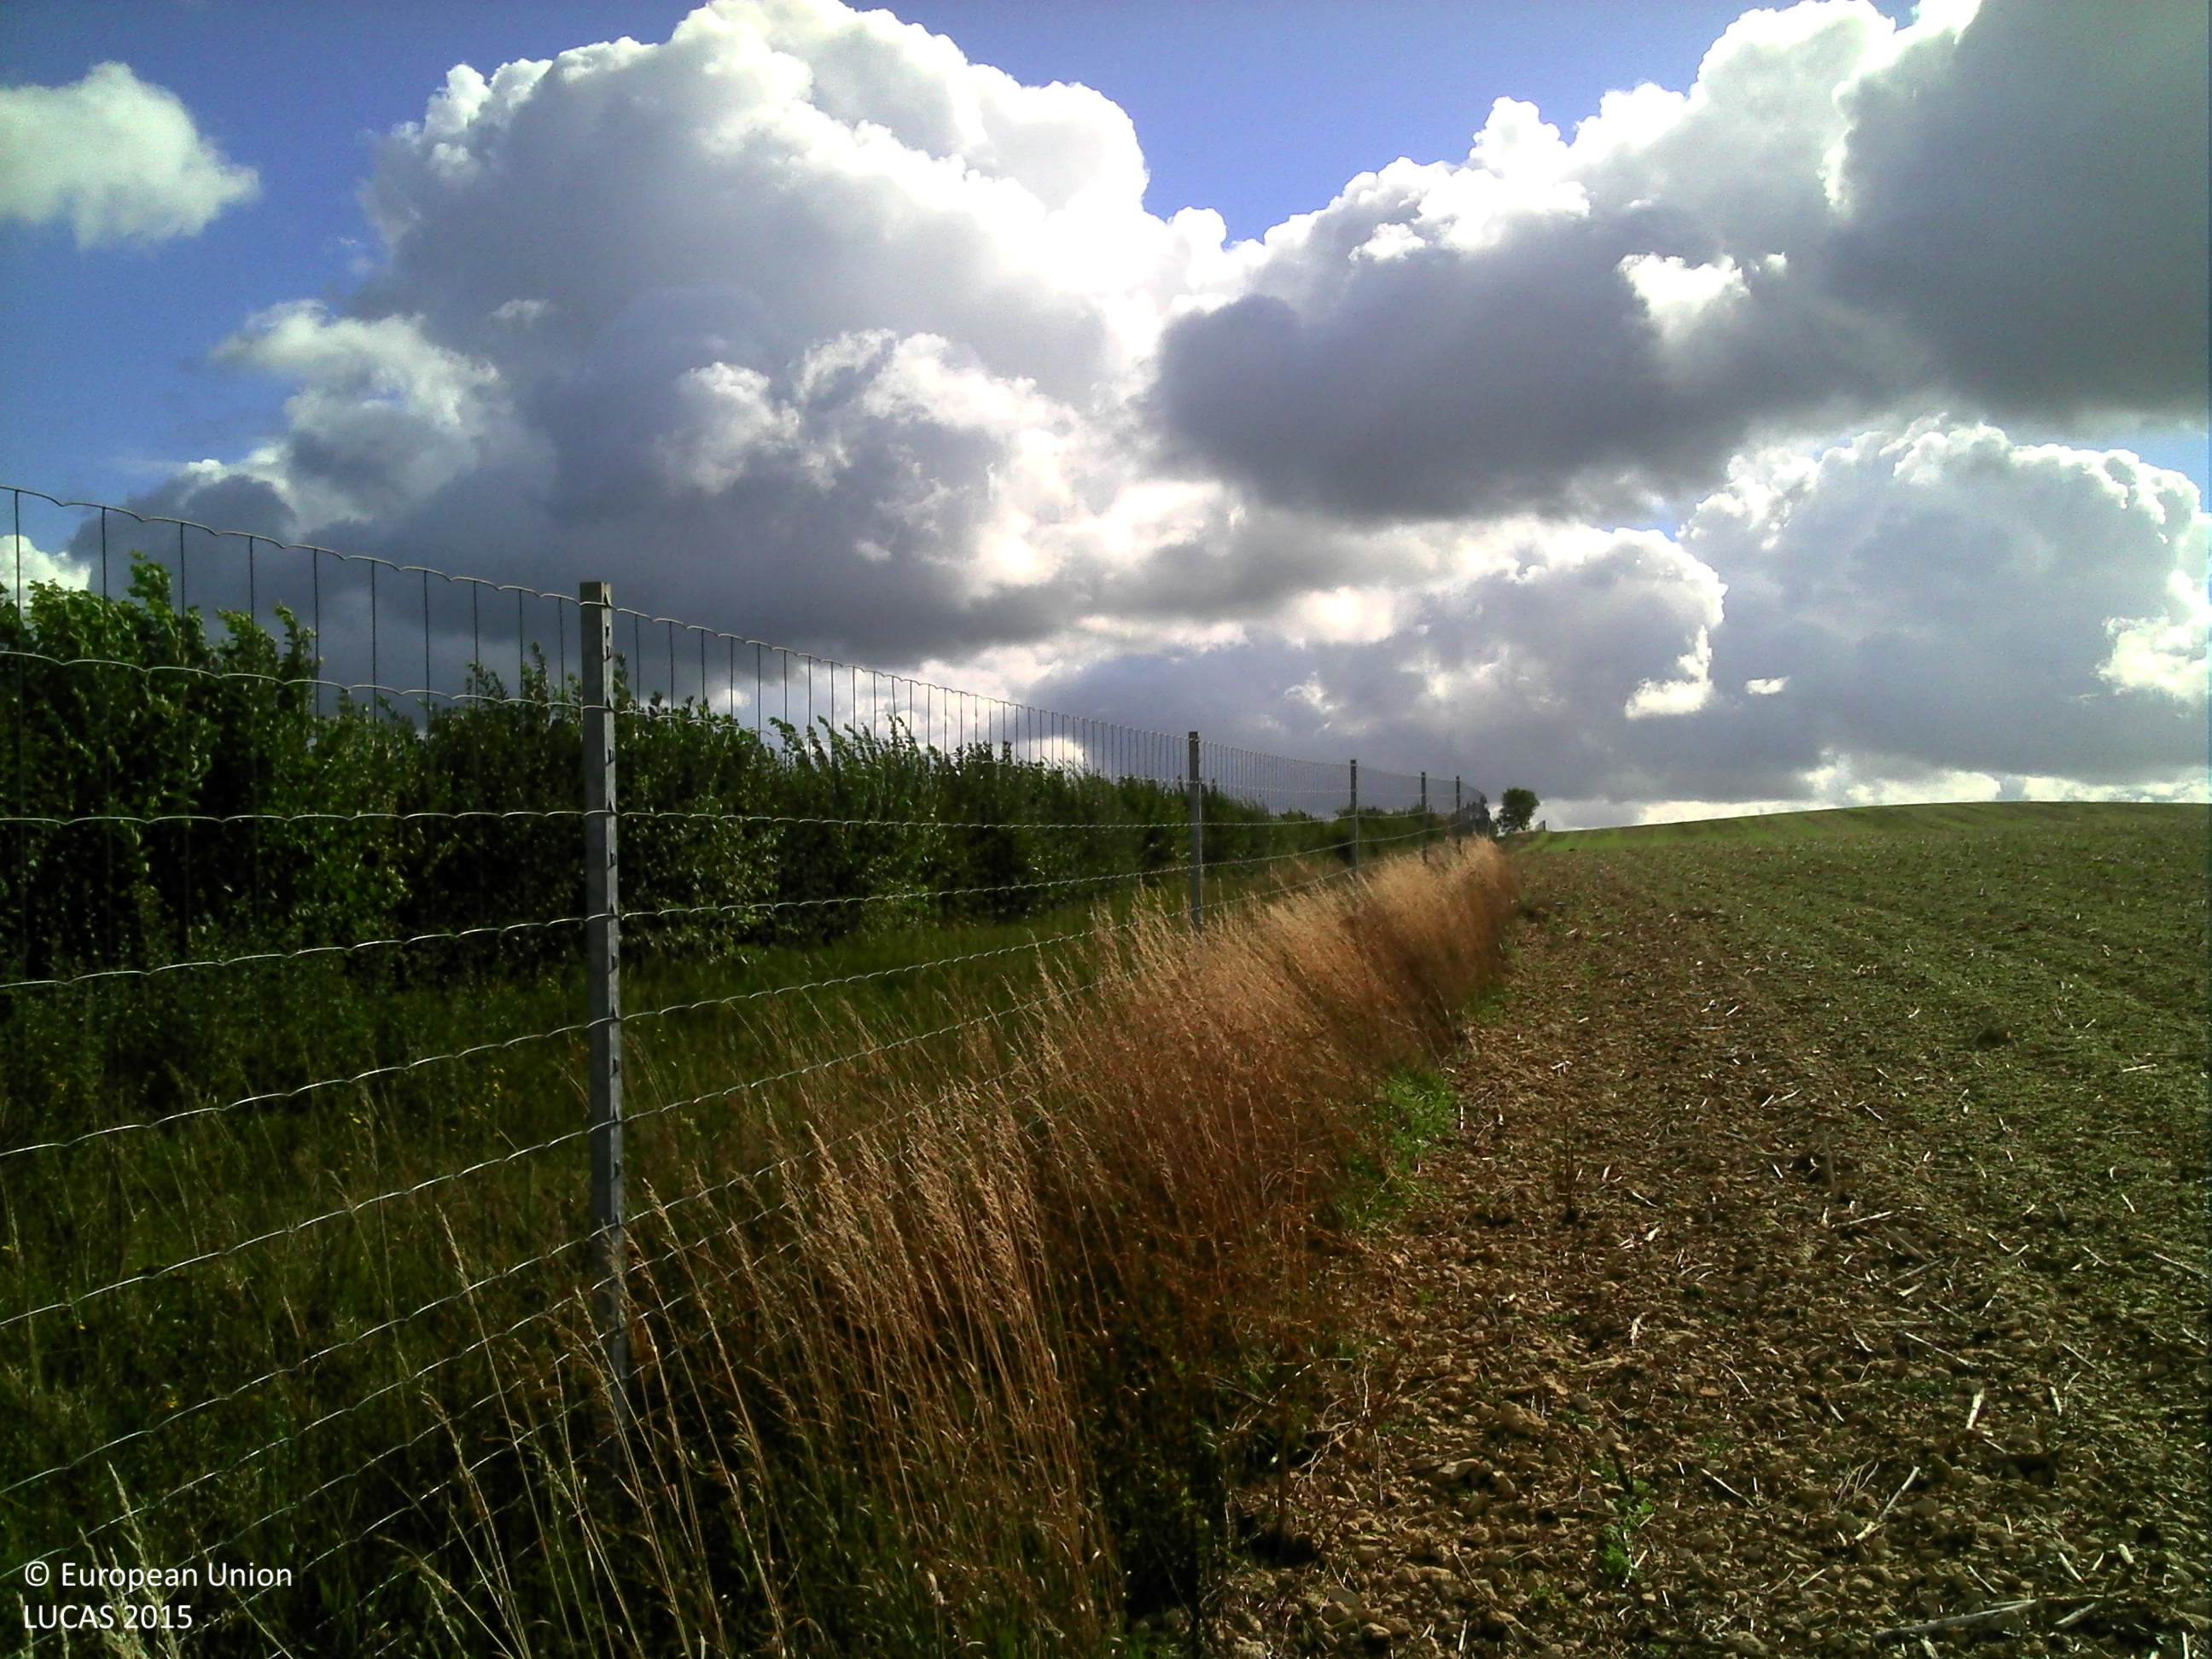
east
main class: Grassland
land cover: Spontaneously vegetated surfaces
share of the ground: > 75 %
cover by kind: herbaceous plants 100 %
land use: Semi-natural and natural areas not in use
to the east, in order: Fences; Spontaneously vegetated surfaces; Managed hedges; Grassland without tree/shrub cover; Paved roads, cycling and walking lanes; Grassland without tree/shrub cover; Managed hedges; Spontaneously vegetated surfaces; Fences; Other bare soil
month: September
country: FR
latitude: 48.1304
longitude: 4.6640
